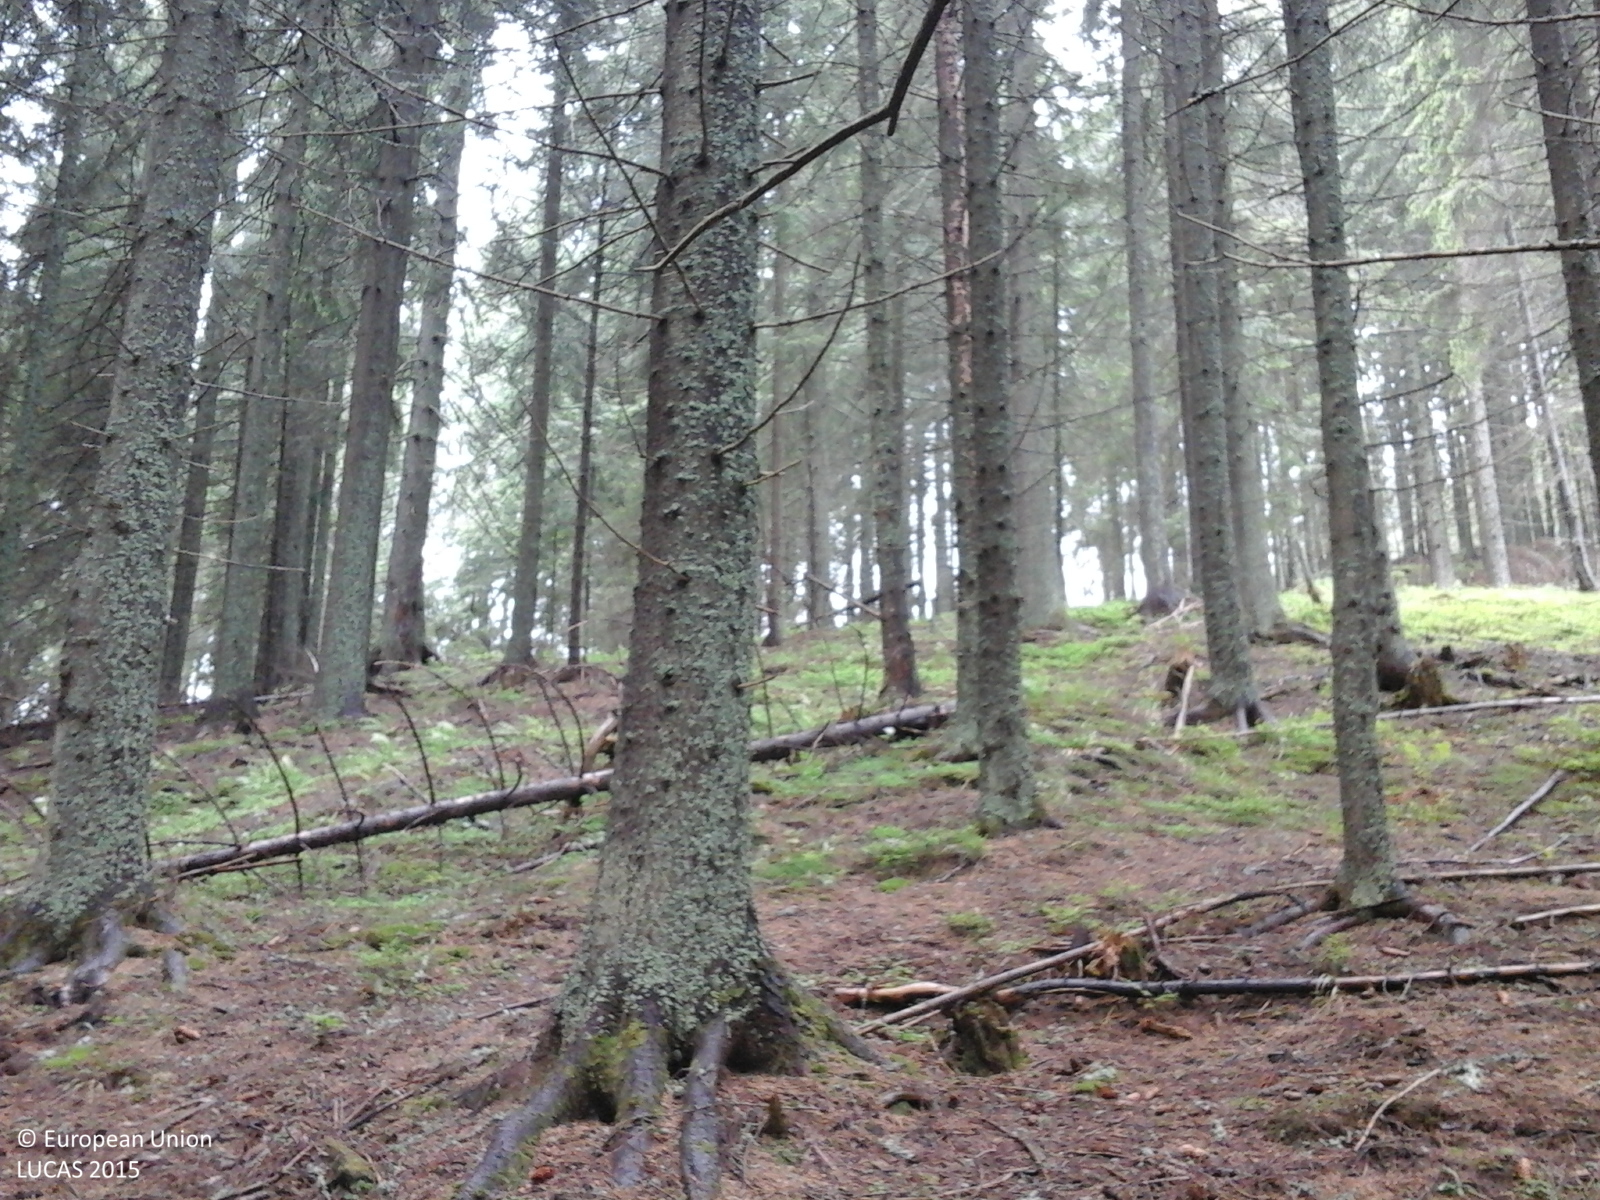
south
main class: Woodland
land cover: Spruce dominated coniferous woodland
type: alpine coniferous forest
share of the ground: > 75 %
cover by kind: coniferous forest trees 100 %
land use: Forestry
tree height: > 5 m
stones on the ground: < 10 %
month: June
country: RO
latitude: 47.6481
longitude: 25.3838
